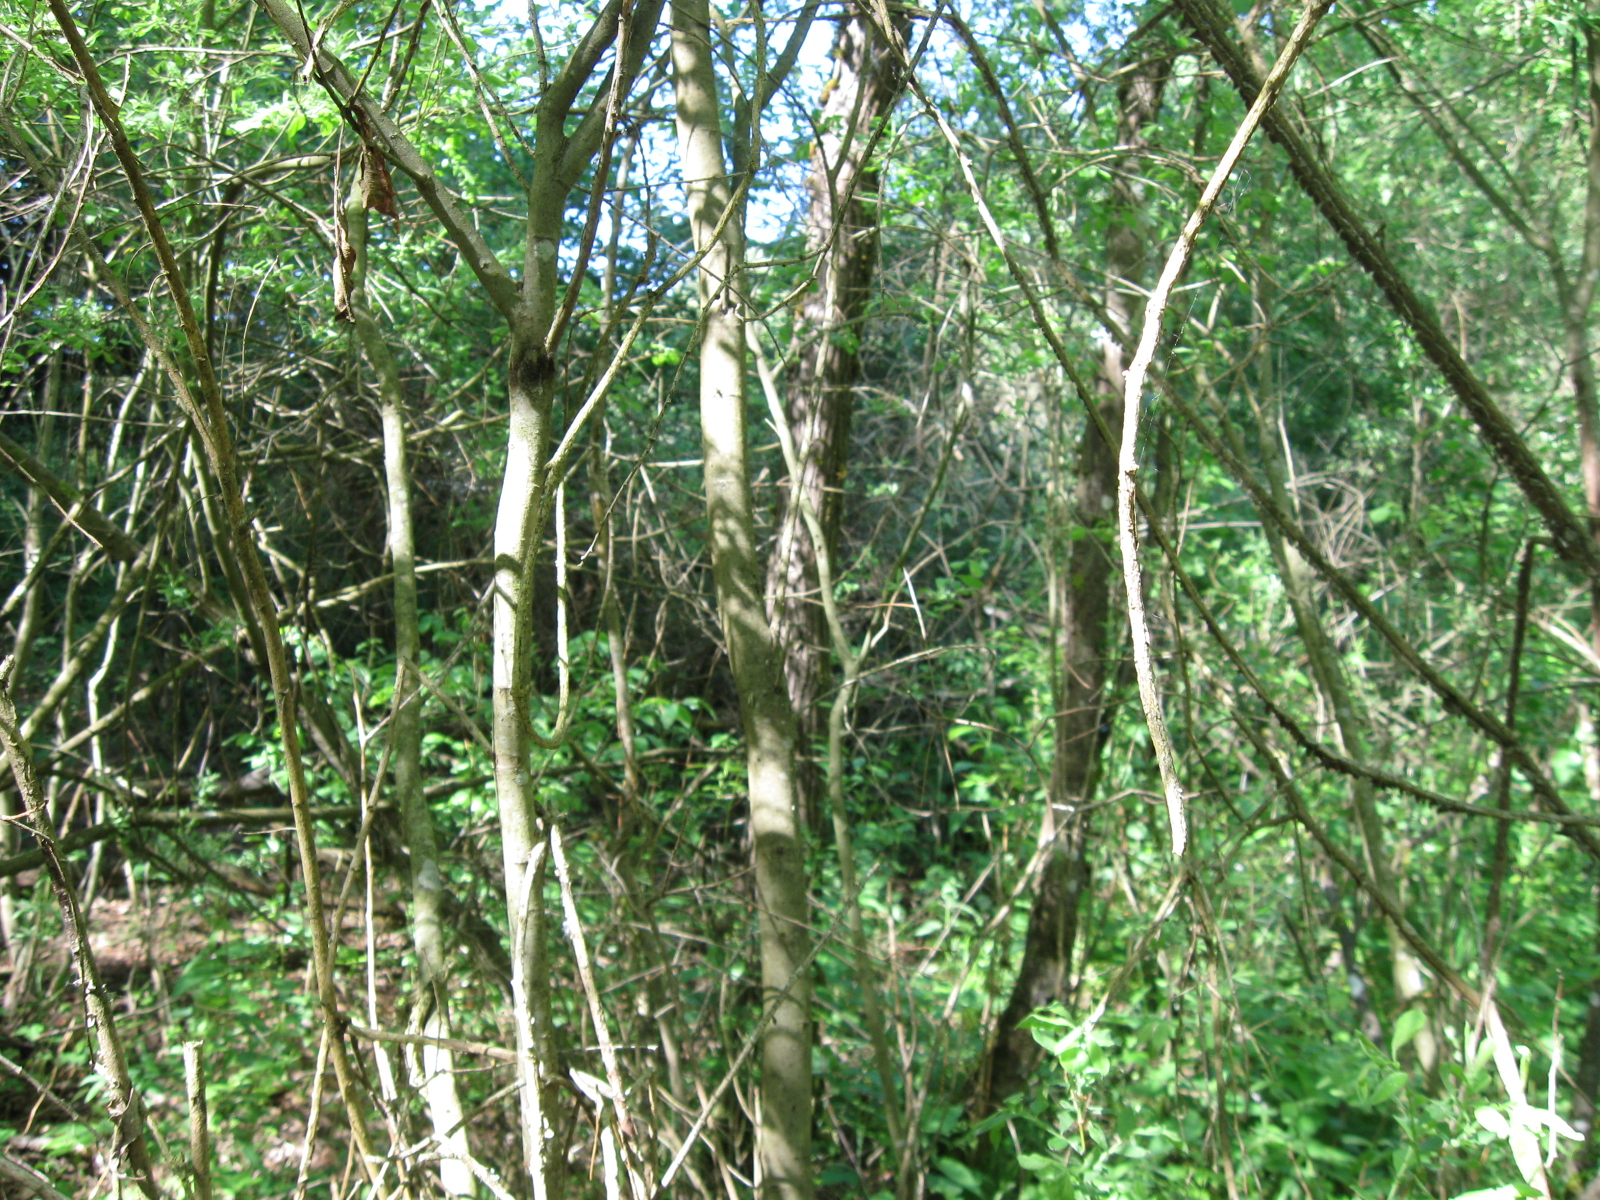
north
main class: Woodland
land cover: Spruce dominated mixed woodland
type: hemiboreal forest and nemoral coniferous forest and mixed broadleaved-coniferous forest
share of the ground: > 75 %
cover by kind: broadleaved forest trees 65 %, coniferous forest trees 30 %, herbaceous plants 5 %
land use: Forestry
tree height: > 5 m
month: June
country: LT
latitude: 54.1058
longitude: 23.6207
